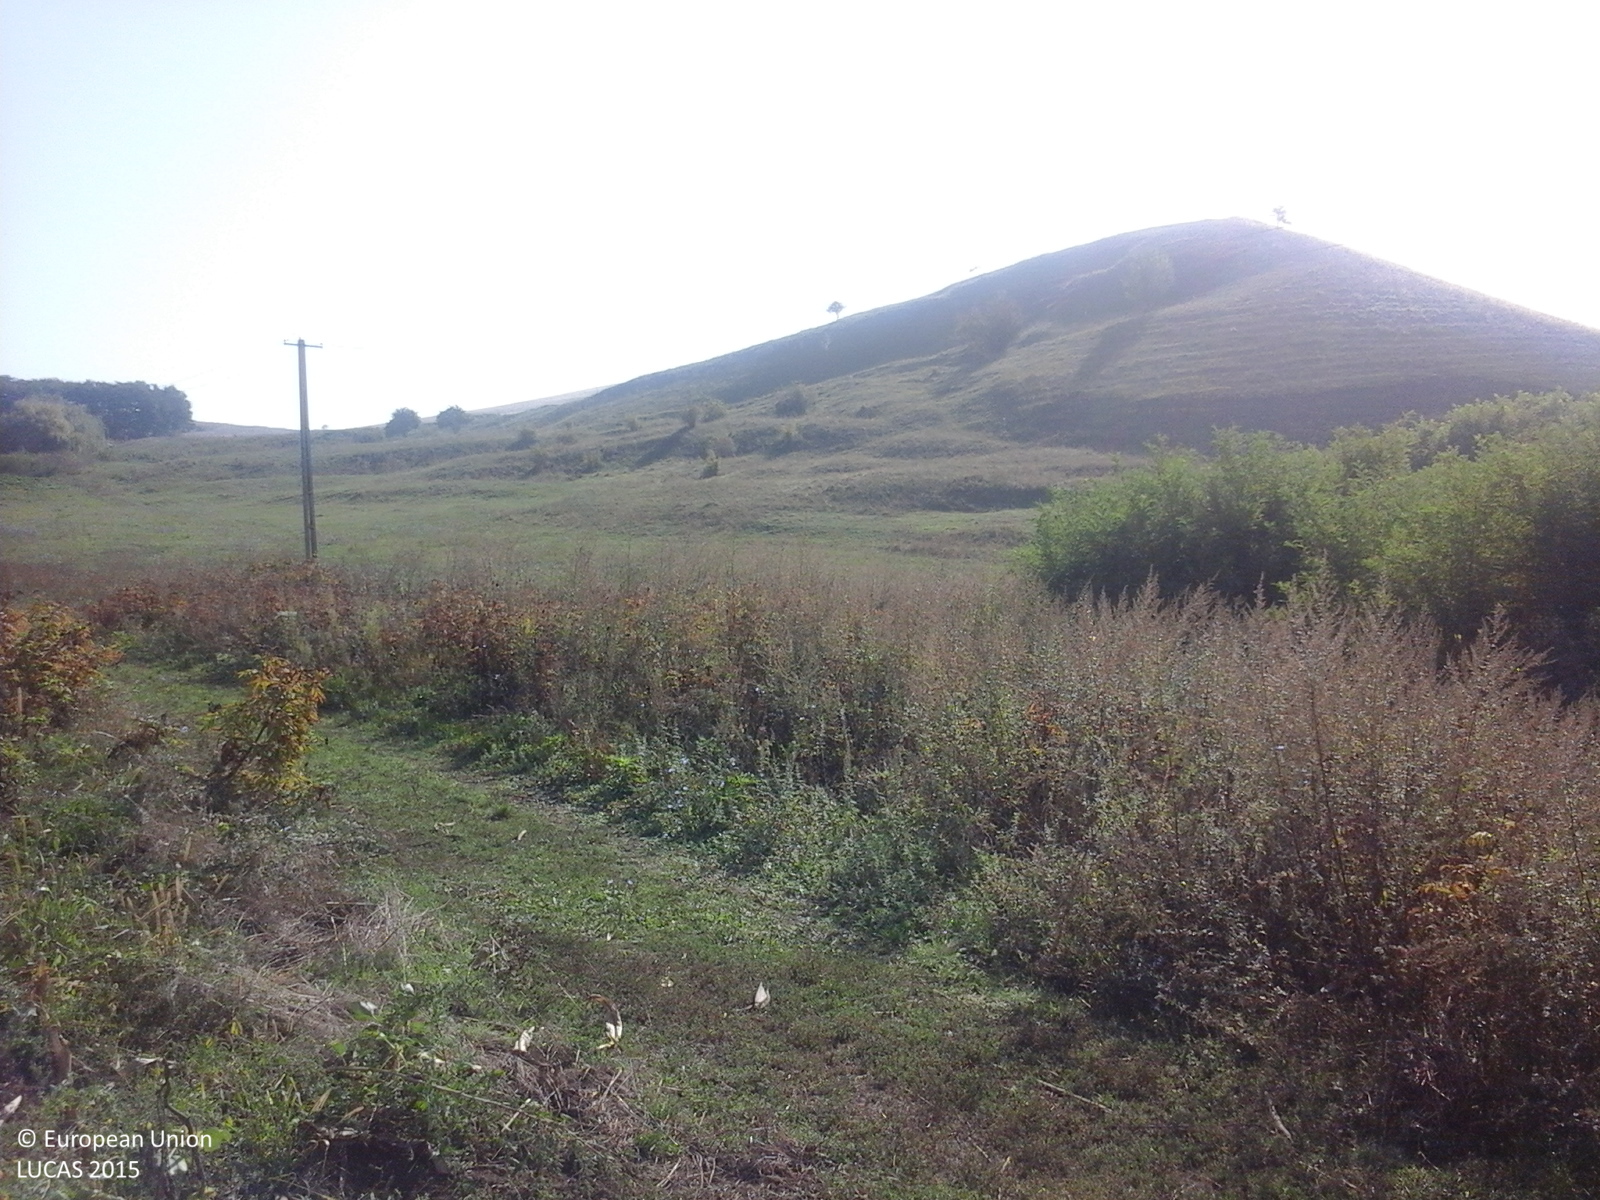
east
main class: Cropland
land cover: Maize
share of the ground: > 75 %
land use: Agriculture (excluding fallow land and kitchen gardens)
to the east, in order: Maize; Grass margins; Tracks; Spontaneously vegetated surfaces; Electric lines; Spontaneously vegetated surfaces; Grassland without tree/shrub cover
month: September
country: RO
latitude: 46.6891
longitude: 24.1104
